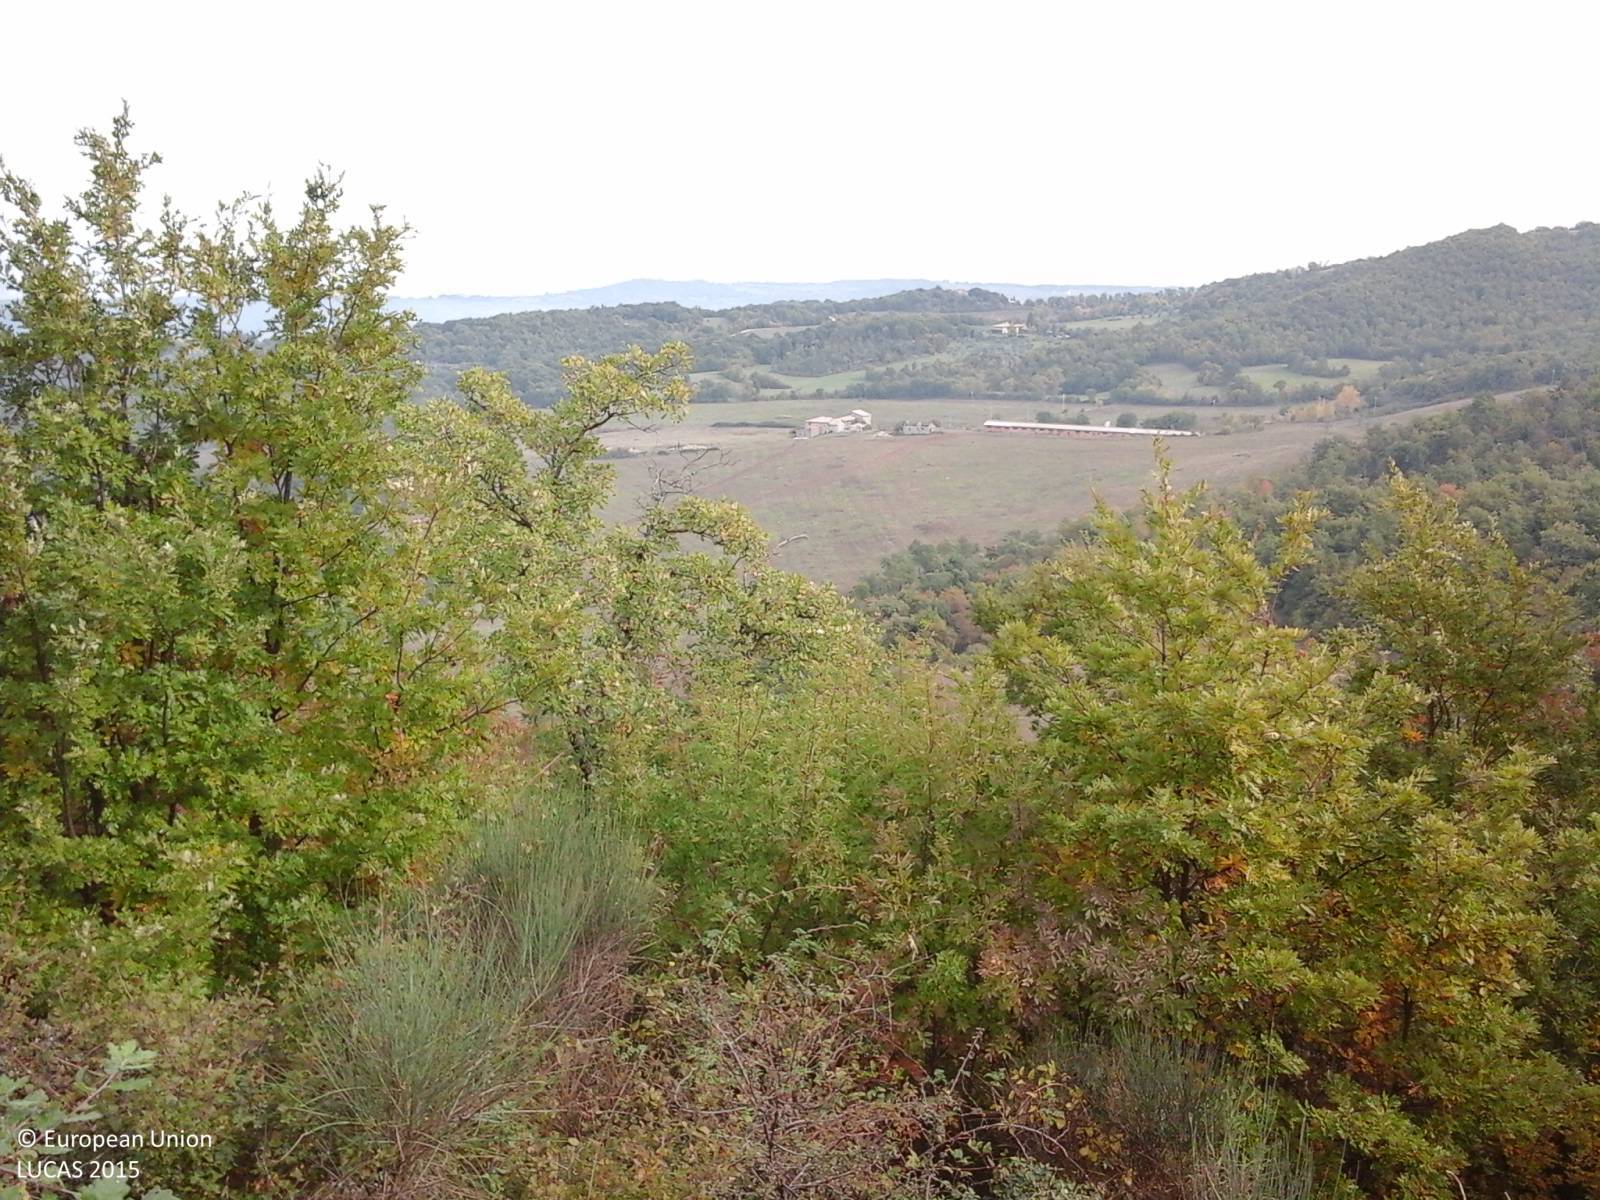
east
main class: Woodland
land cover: Broadleaved woodland
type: thermophilous deciduous forest
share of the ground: > 75 %
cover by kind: broadleaved forest trees 100 %
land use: Forestry
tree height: > 5 m
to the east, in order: Broadleaved woodland; Grassland without tree/shrub cover
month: October
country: IT
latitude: 42.7177
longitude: 12.3249
